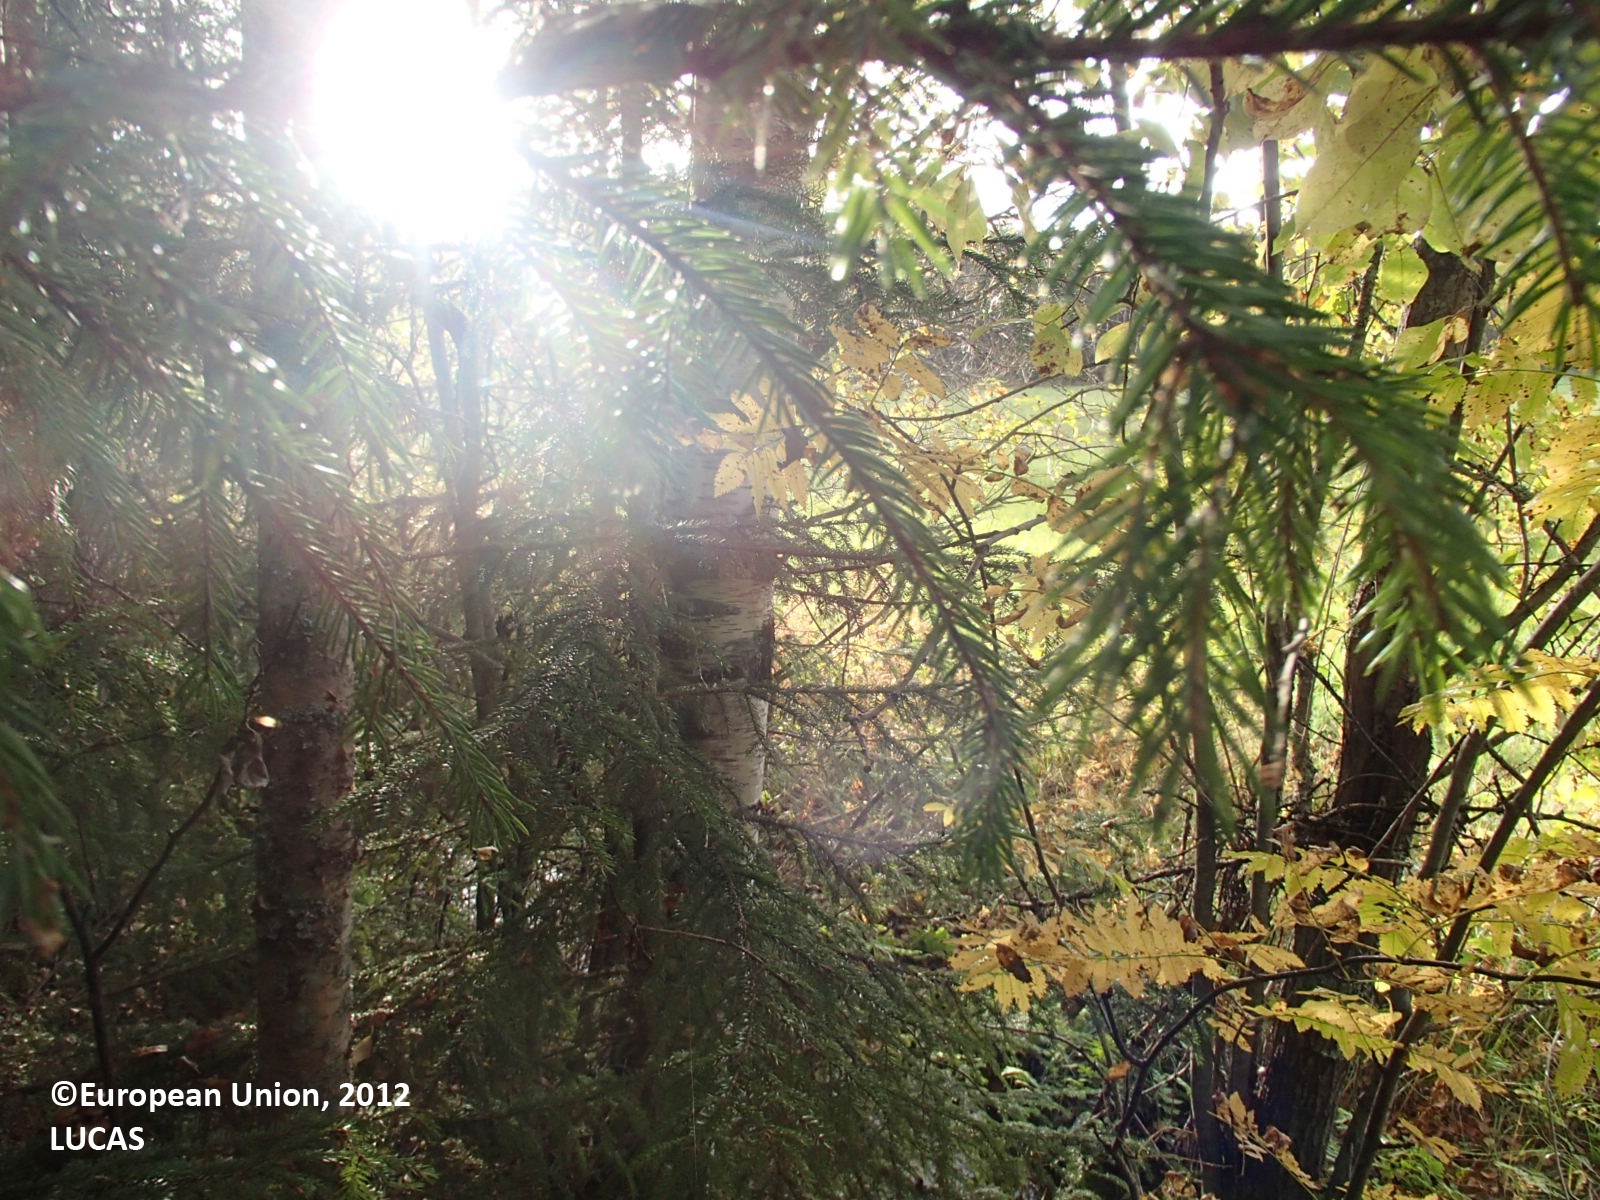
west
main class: Woodland
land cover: Spruce dominated mixed woodland
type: boreal forest
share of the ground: > 75 %
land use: Forestry
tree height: > 5 m
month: September
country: FI
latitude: 63.3448
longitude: 27.7682
